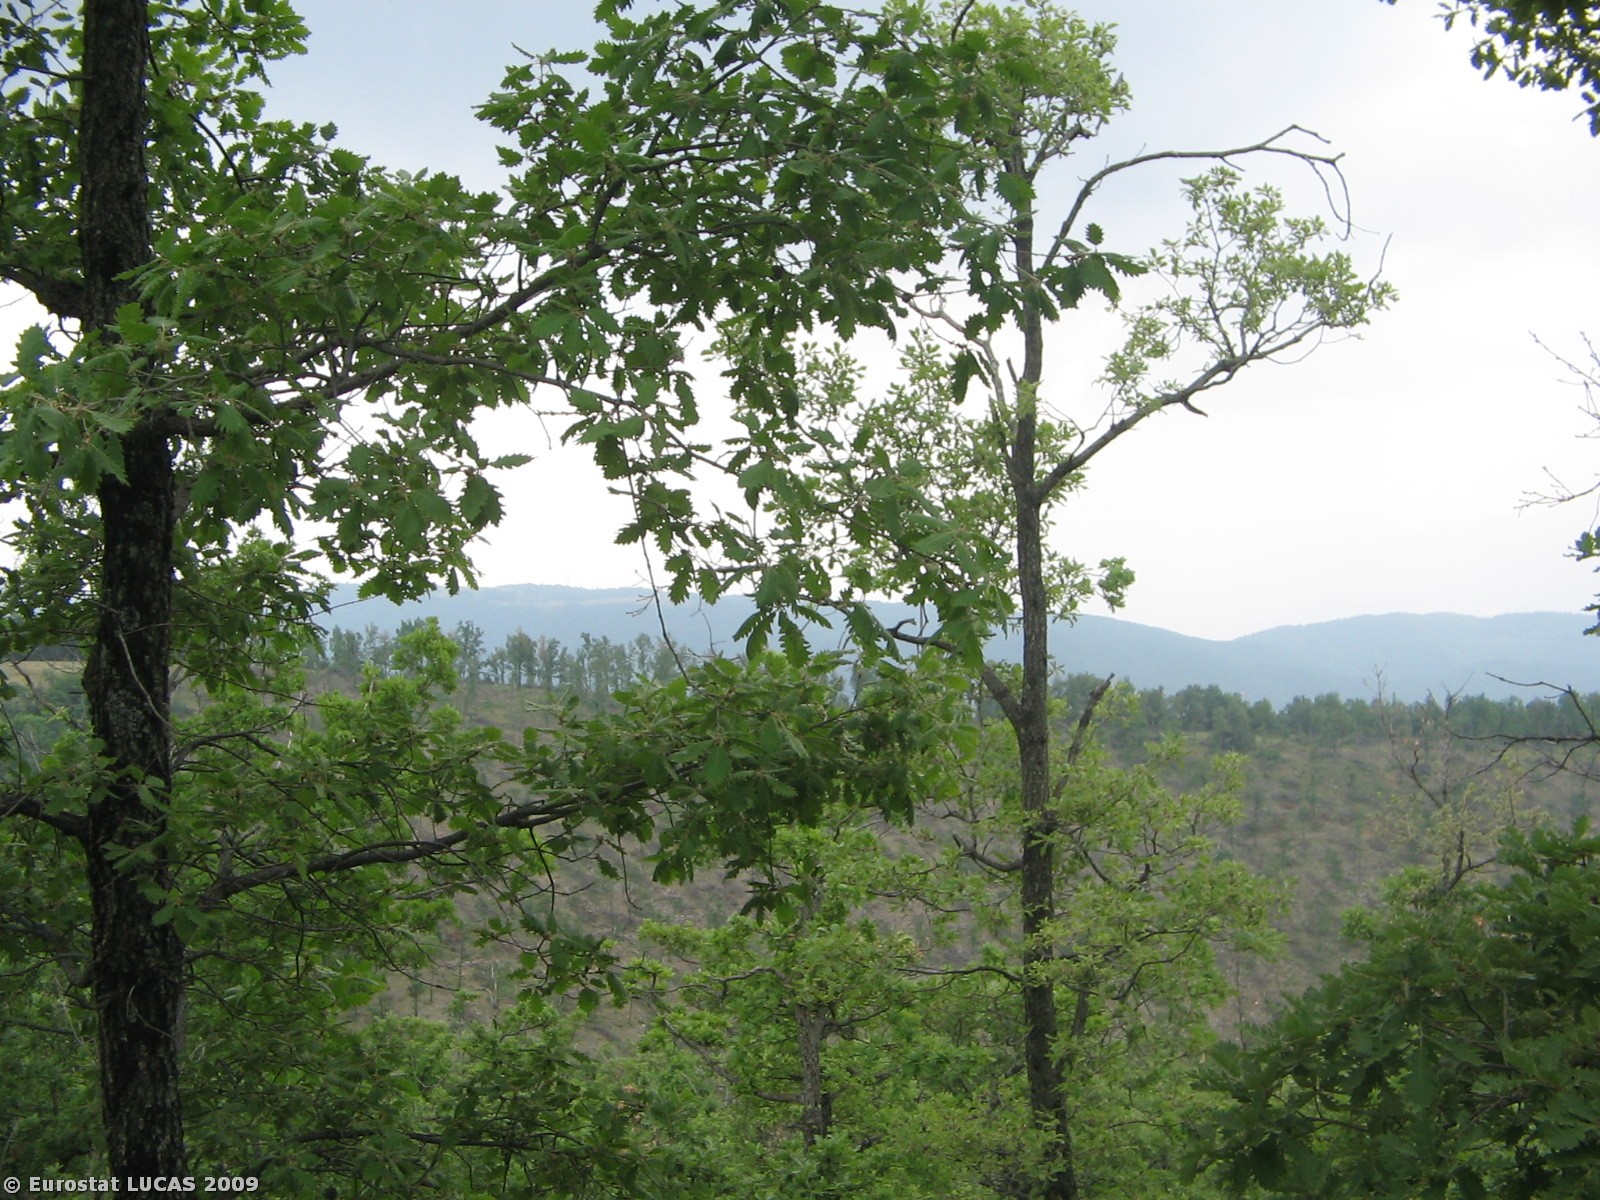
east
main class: Woodland
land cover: Broadleaved woodland
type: acidophilous oak and oak-birch forest
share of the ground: > 75 %
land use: Forestry
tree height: > 5 m
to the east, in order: Broadleaved woodland; Tracks; Rock outcrops; Broadleaved woodland
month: May
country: IT
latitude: 42.5964
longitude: 12.8307
